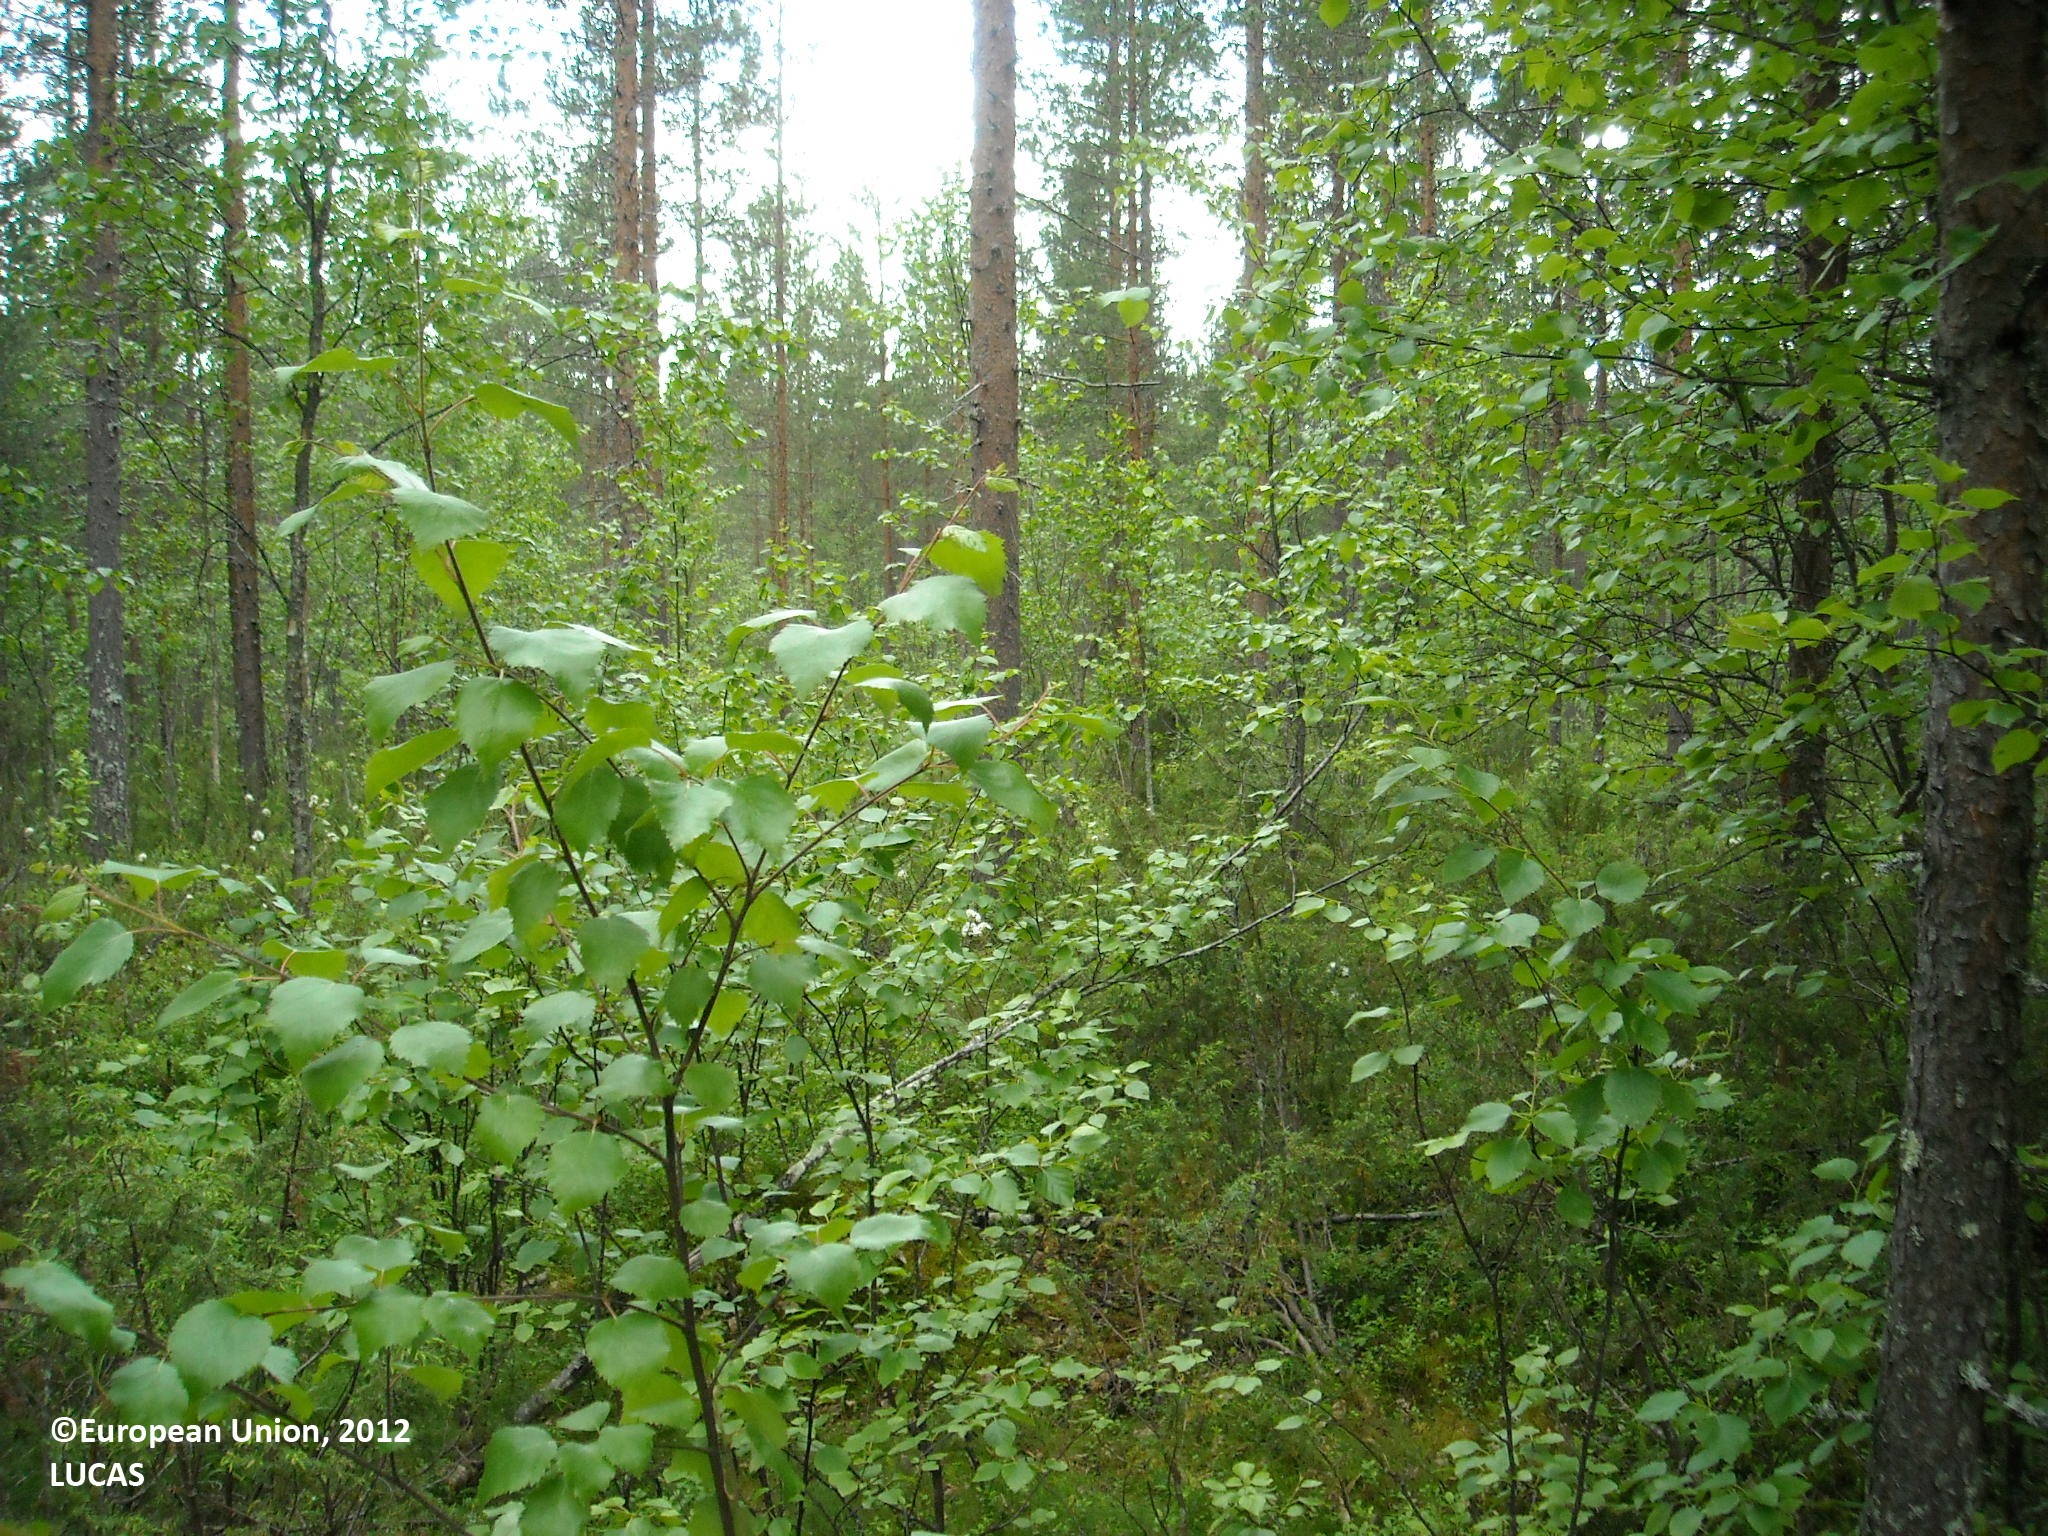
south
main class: Woodland
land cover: Pine dominated mixed woodland
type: boreal forest
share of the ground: > 75 %
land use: Forestry
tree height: > 5 m
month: June
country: FI
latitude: 64.8087
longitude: 27.3370
